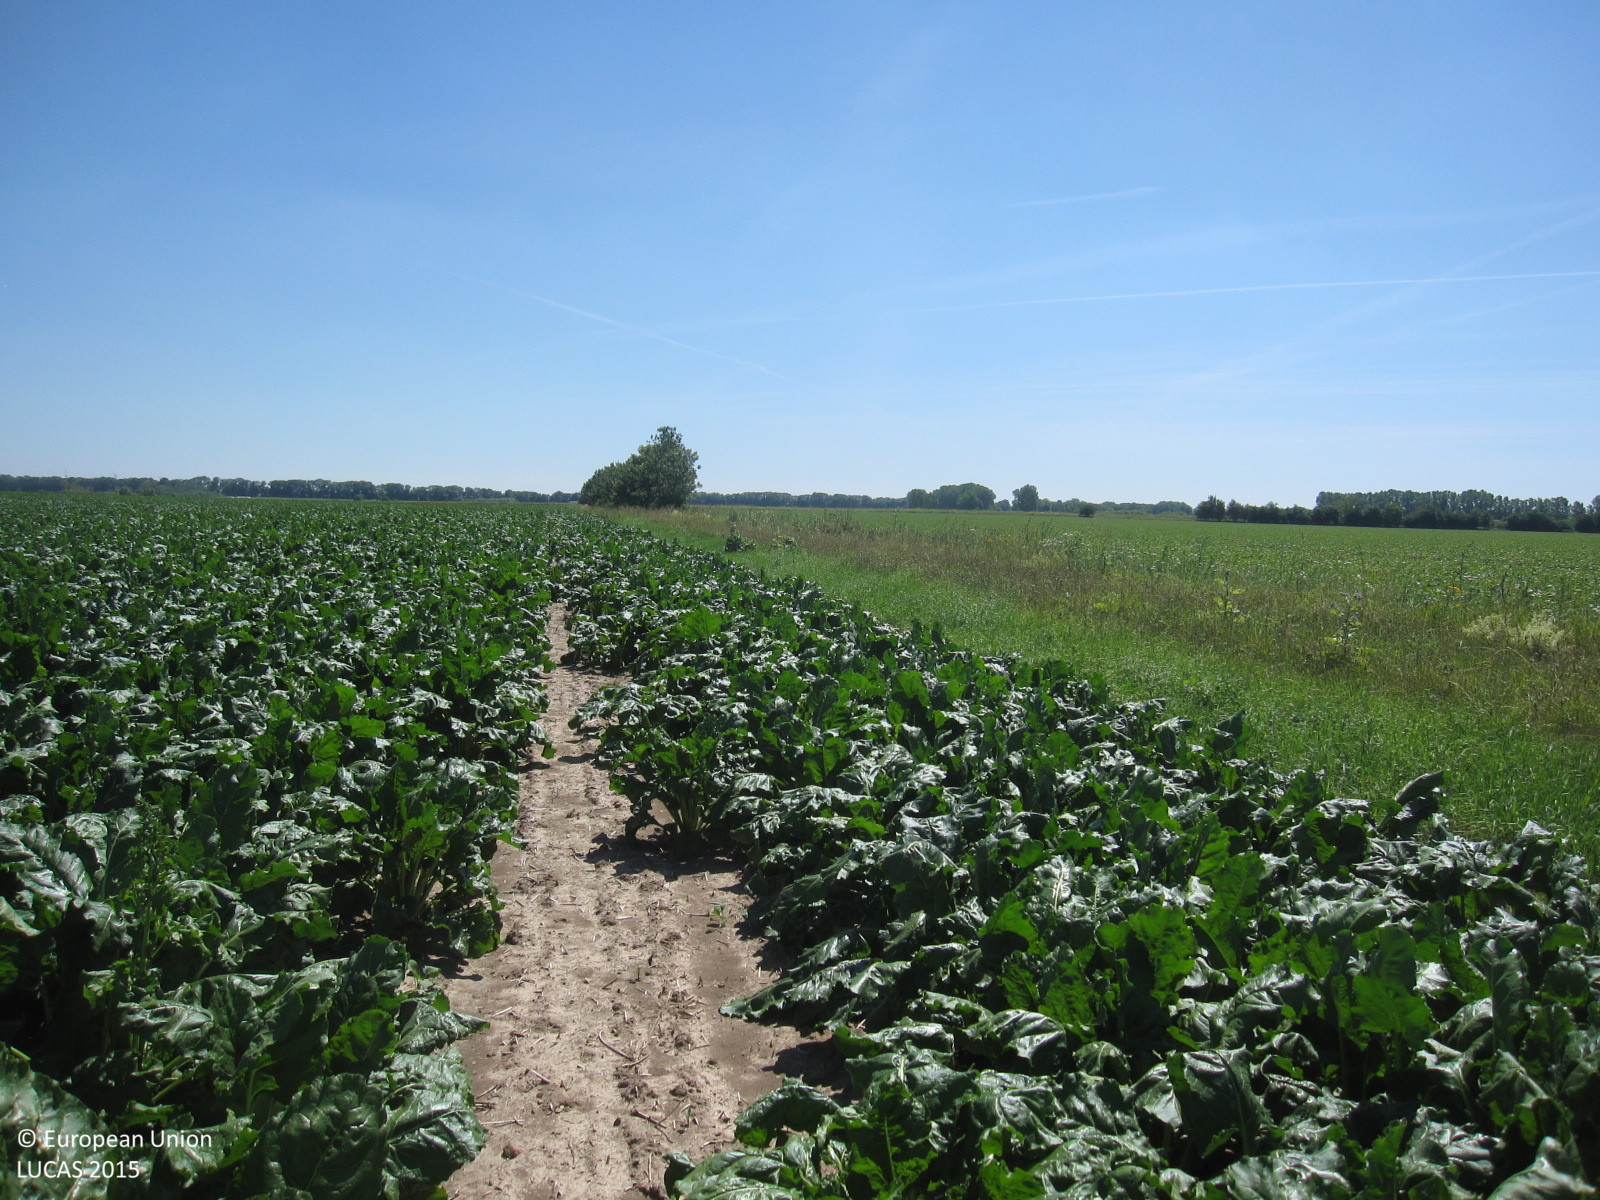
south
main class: Cropland
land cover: Sugar beet
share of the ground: > 75 %
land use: Agriculture (excluding fallow land and kitchen gardens)
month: July
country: DE
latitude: 51.2424
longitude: 12.1914
